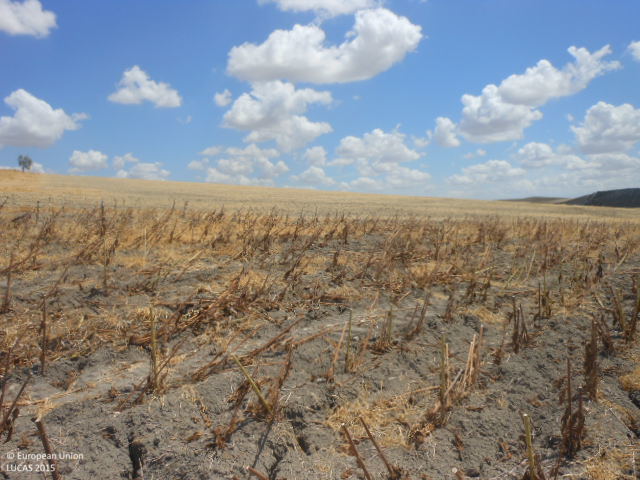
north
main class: Cropland
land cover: Sunflower
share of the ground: < 10 %
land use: Agriculture (excluding fallow land and kitchen gardens)
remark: Harvested field
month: July
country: ES
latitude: 37.4074
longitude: -5.3907
